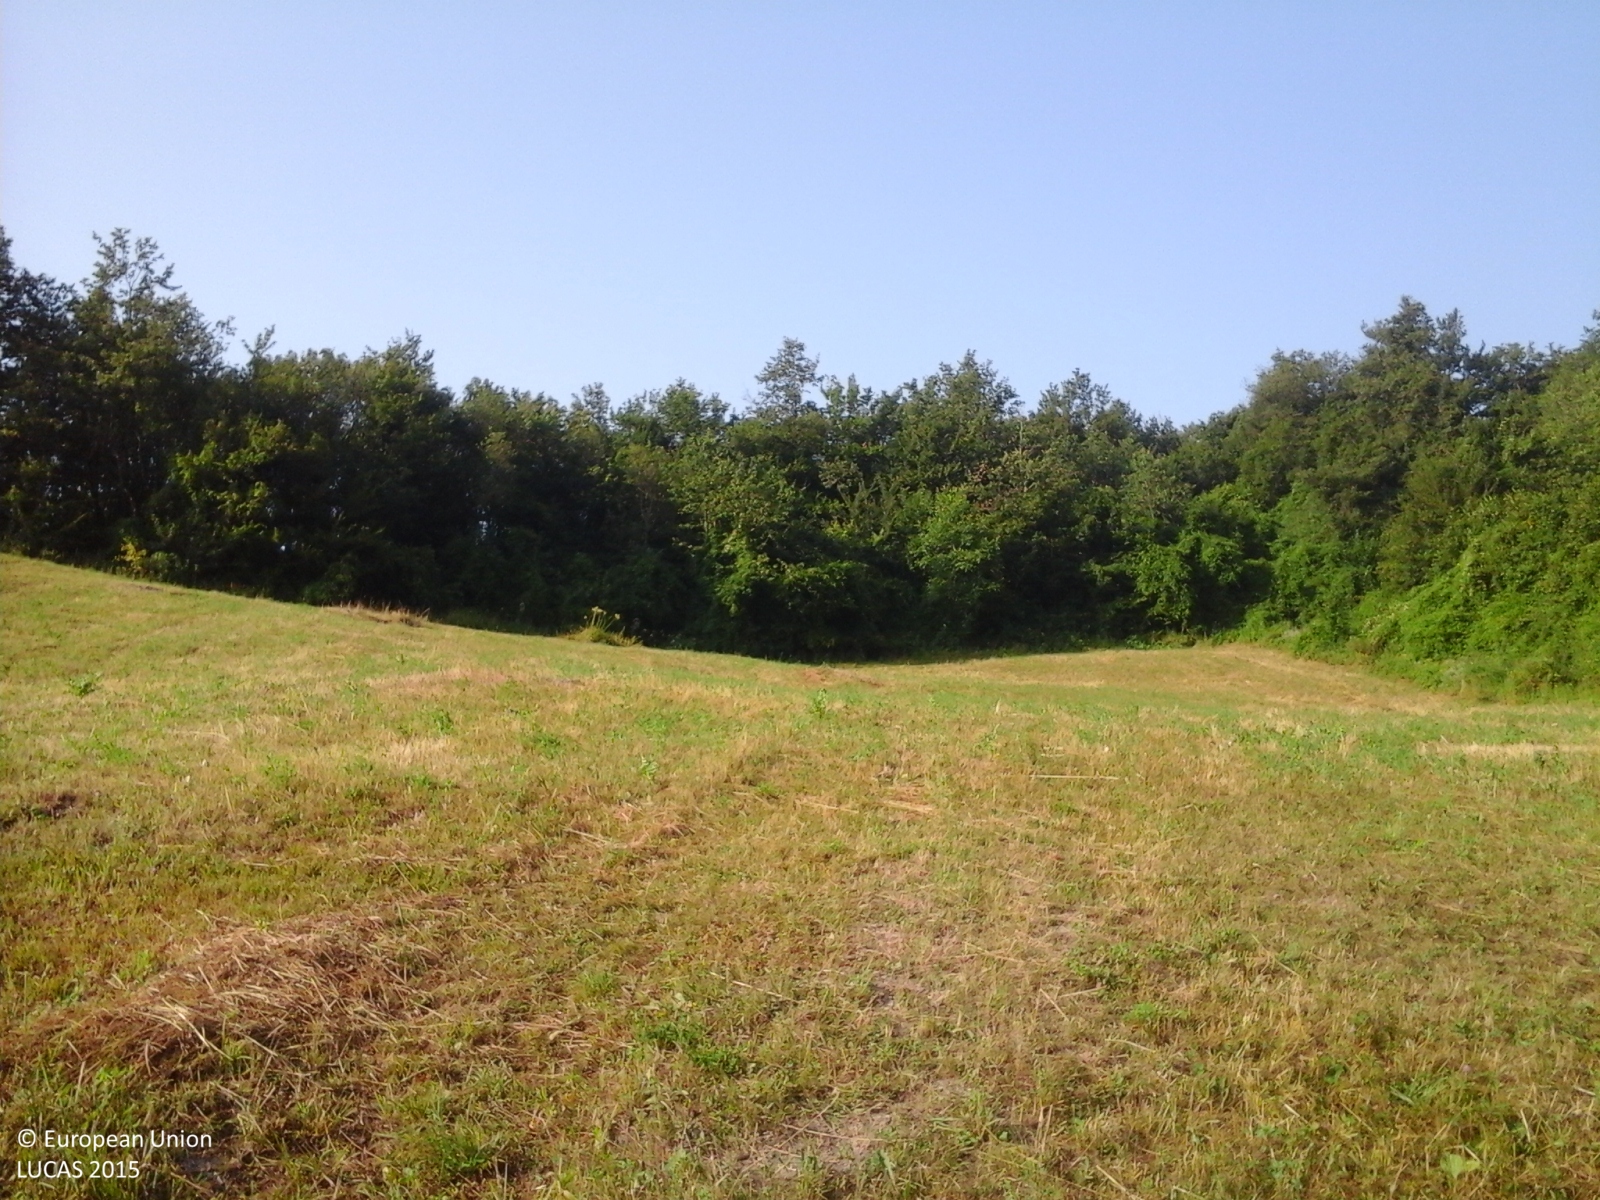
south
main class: Cropland
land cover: Lucerne
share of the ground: > 75 %
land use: Agriculture (excluding fallow land and kitchen gardens)
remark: Harvested field
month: July
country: IT
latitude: 44.4225
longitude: 10.2130
